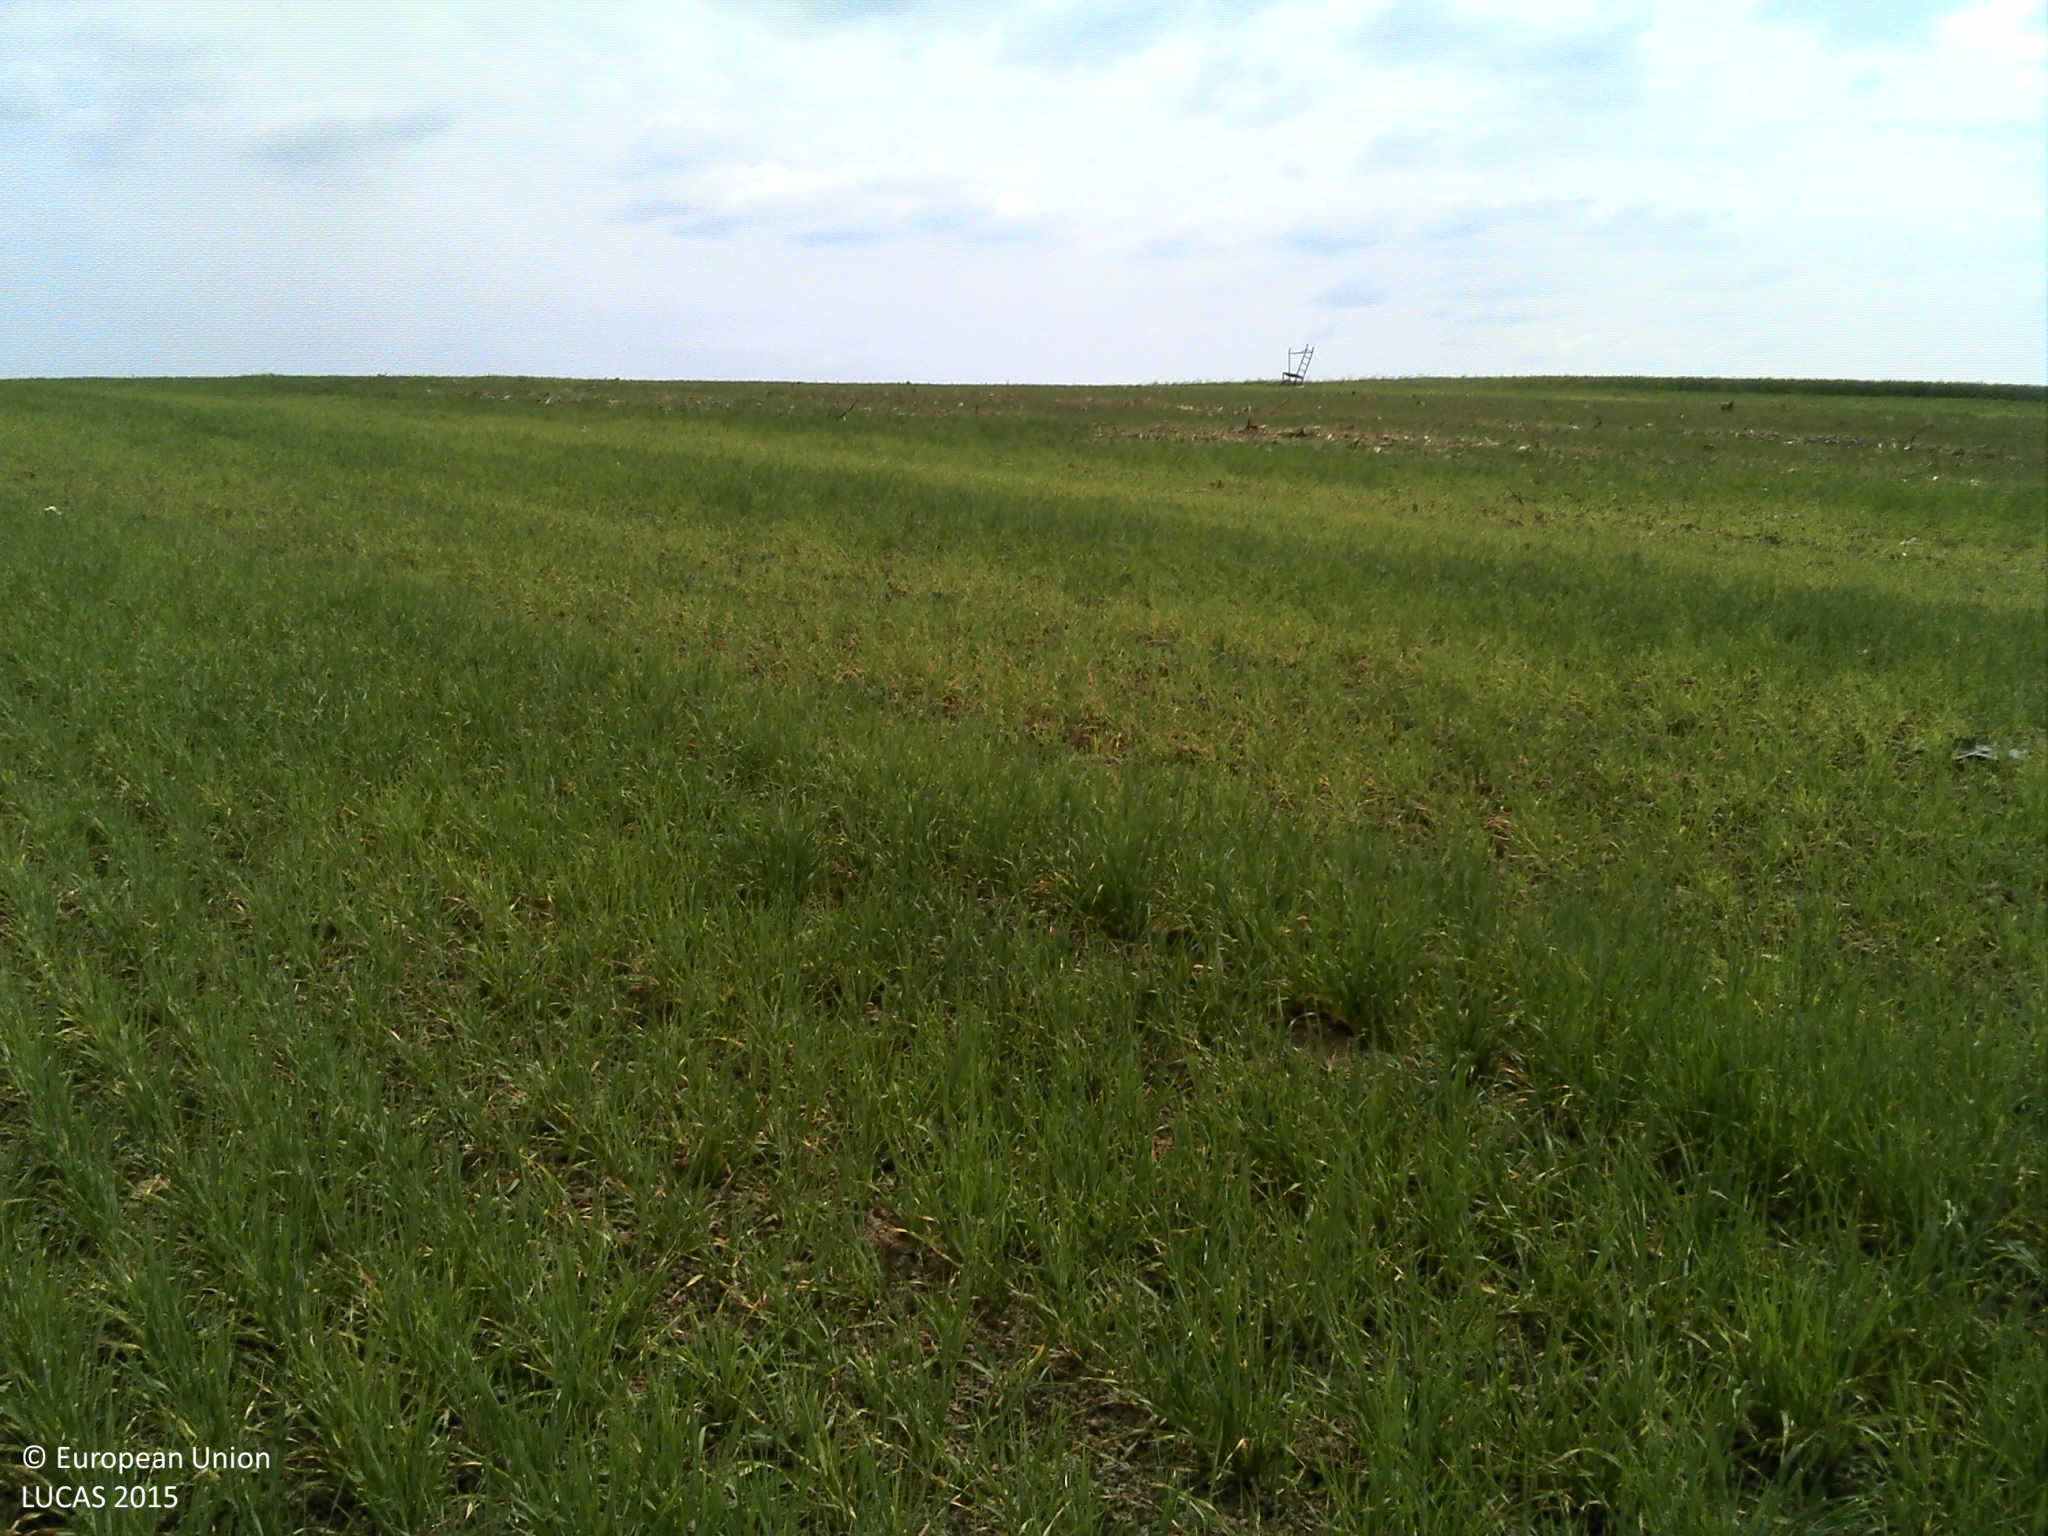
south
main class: Cropland
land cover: Barley
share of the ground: > 75 %
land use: Agriculture (excluding fallow land and kitchen gardens)
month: June
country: FR
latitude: 48.6628
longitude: 6.7827
